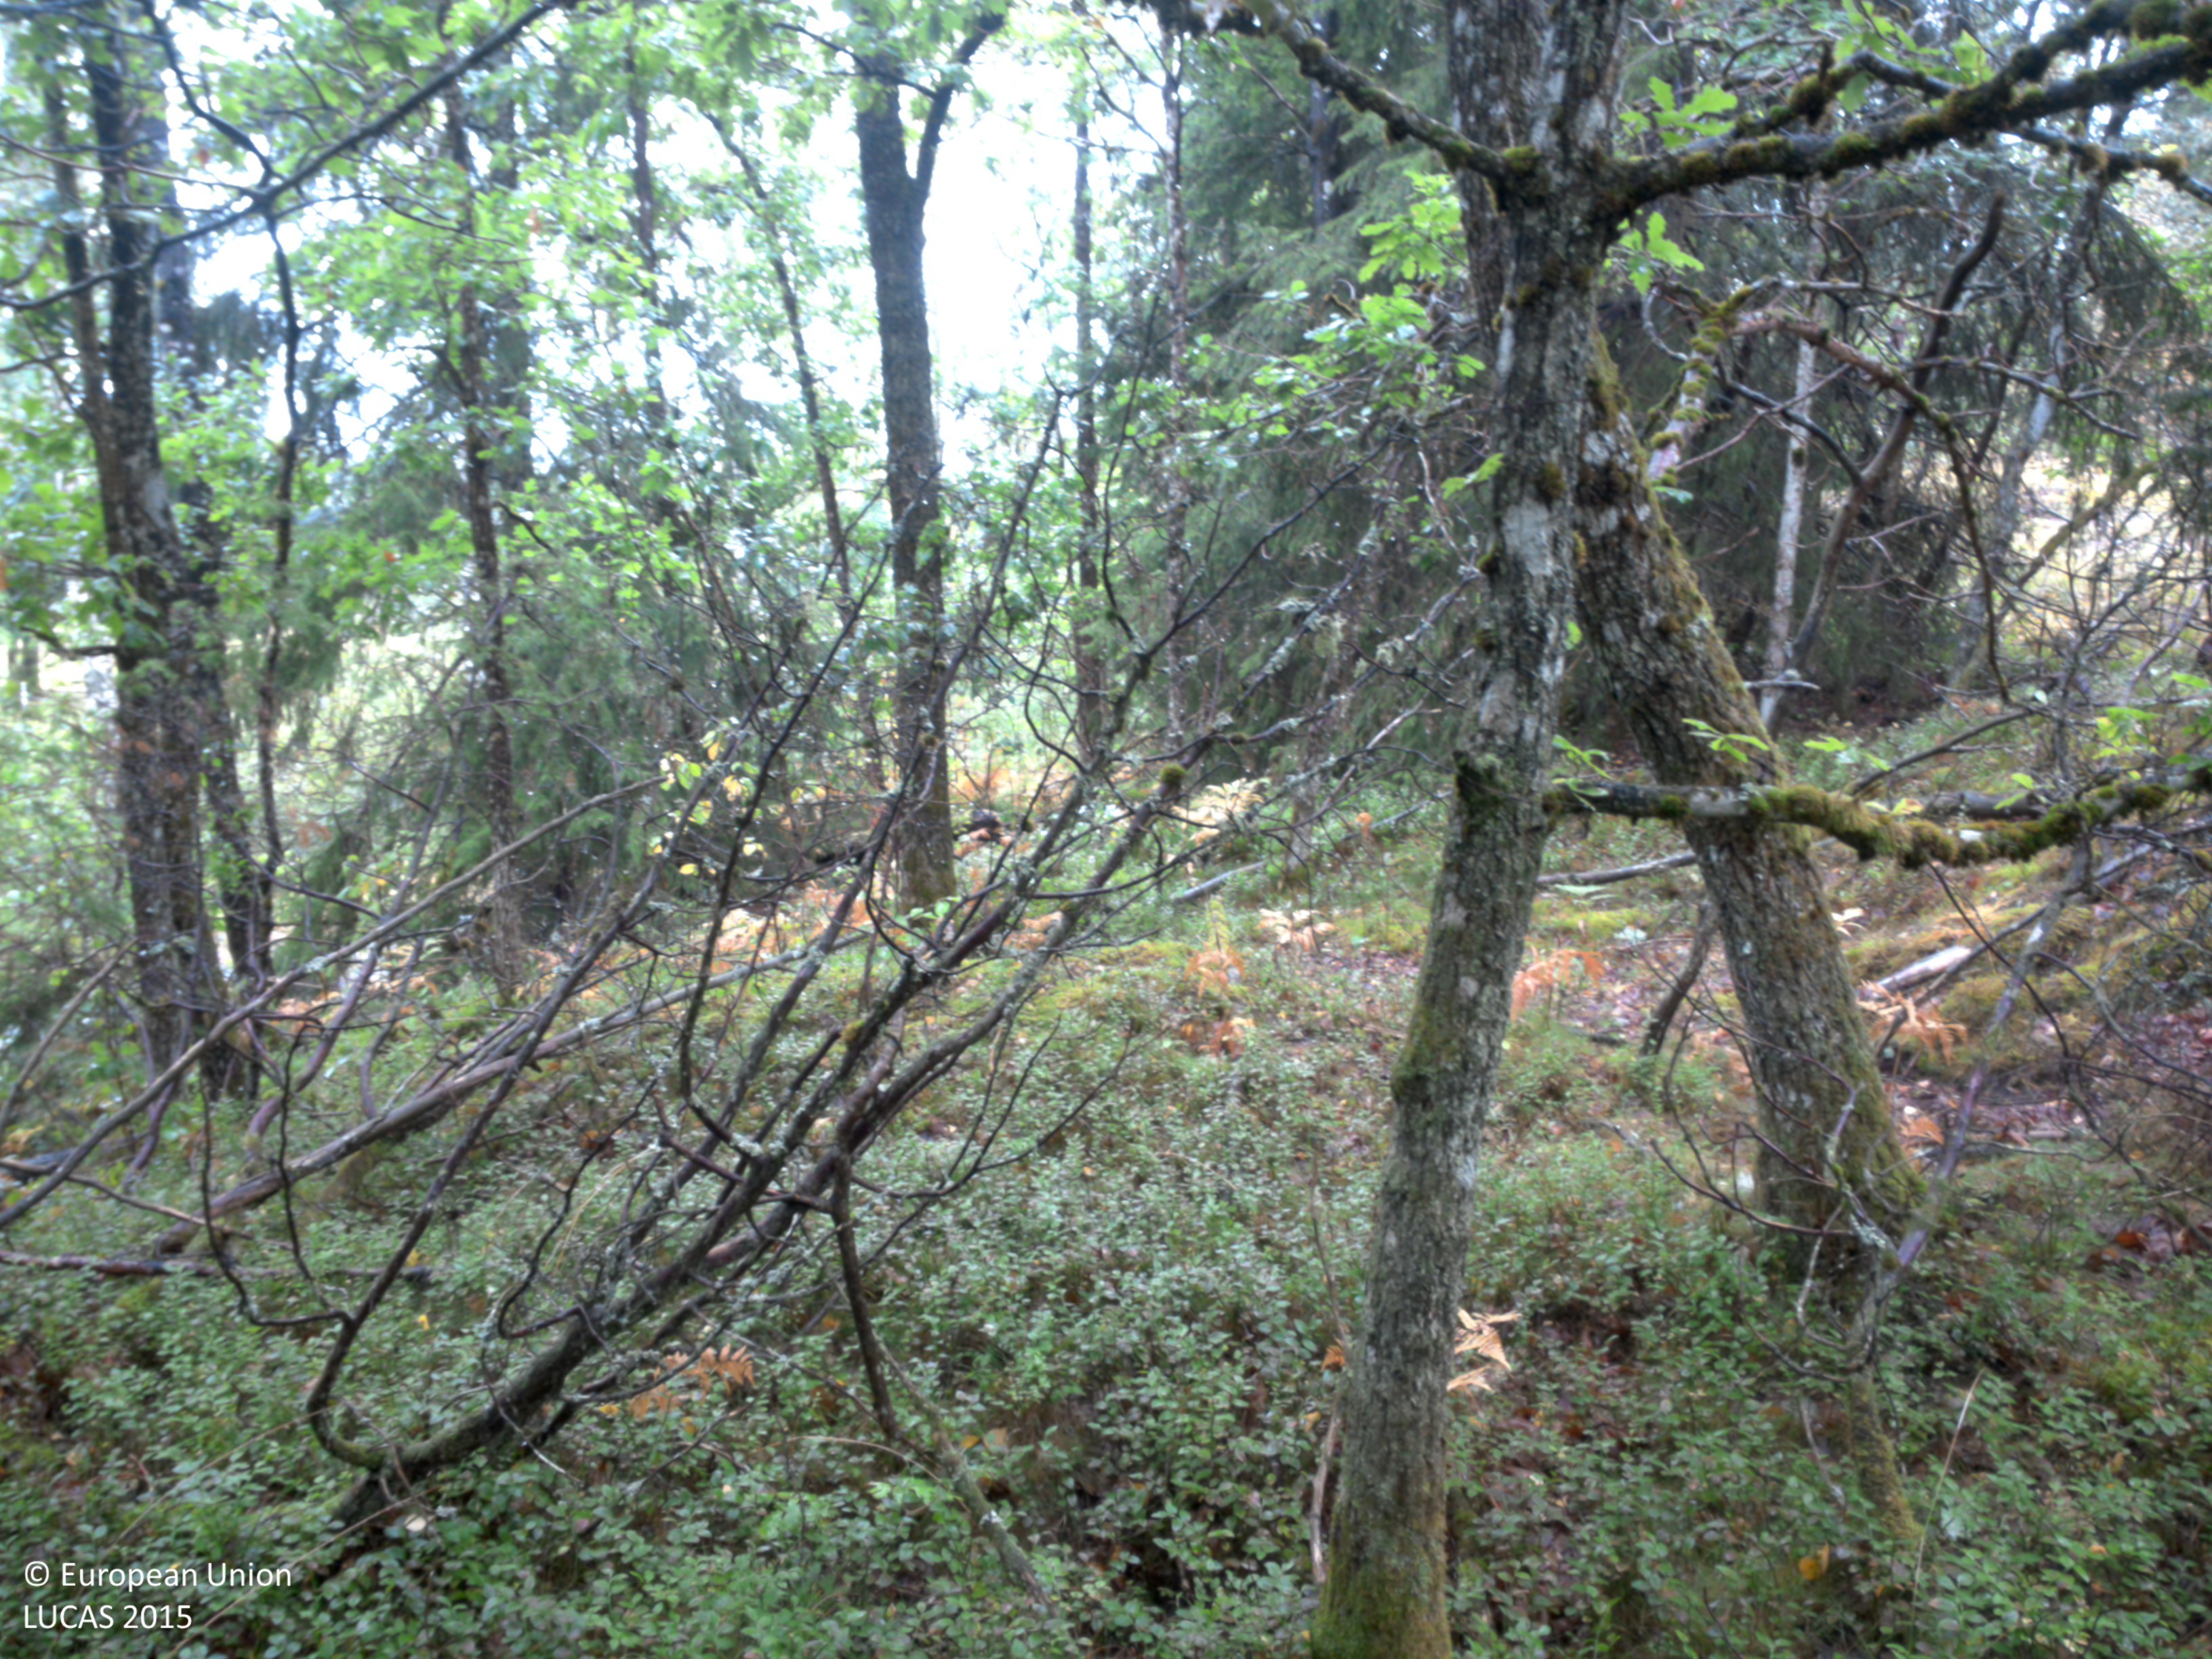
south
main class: Woodland
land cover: Other mixed woodland
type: boreal forest
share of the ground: 50 - 75 %
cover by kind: coniferous forest trees 30 %, broadleaved forest trees 30 %, herbaceous plants 30 %, lichens and mosses 10 %
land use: Forestry
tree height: > 5 m
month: August
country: SE
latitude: 58.1634
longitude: 12.3243
